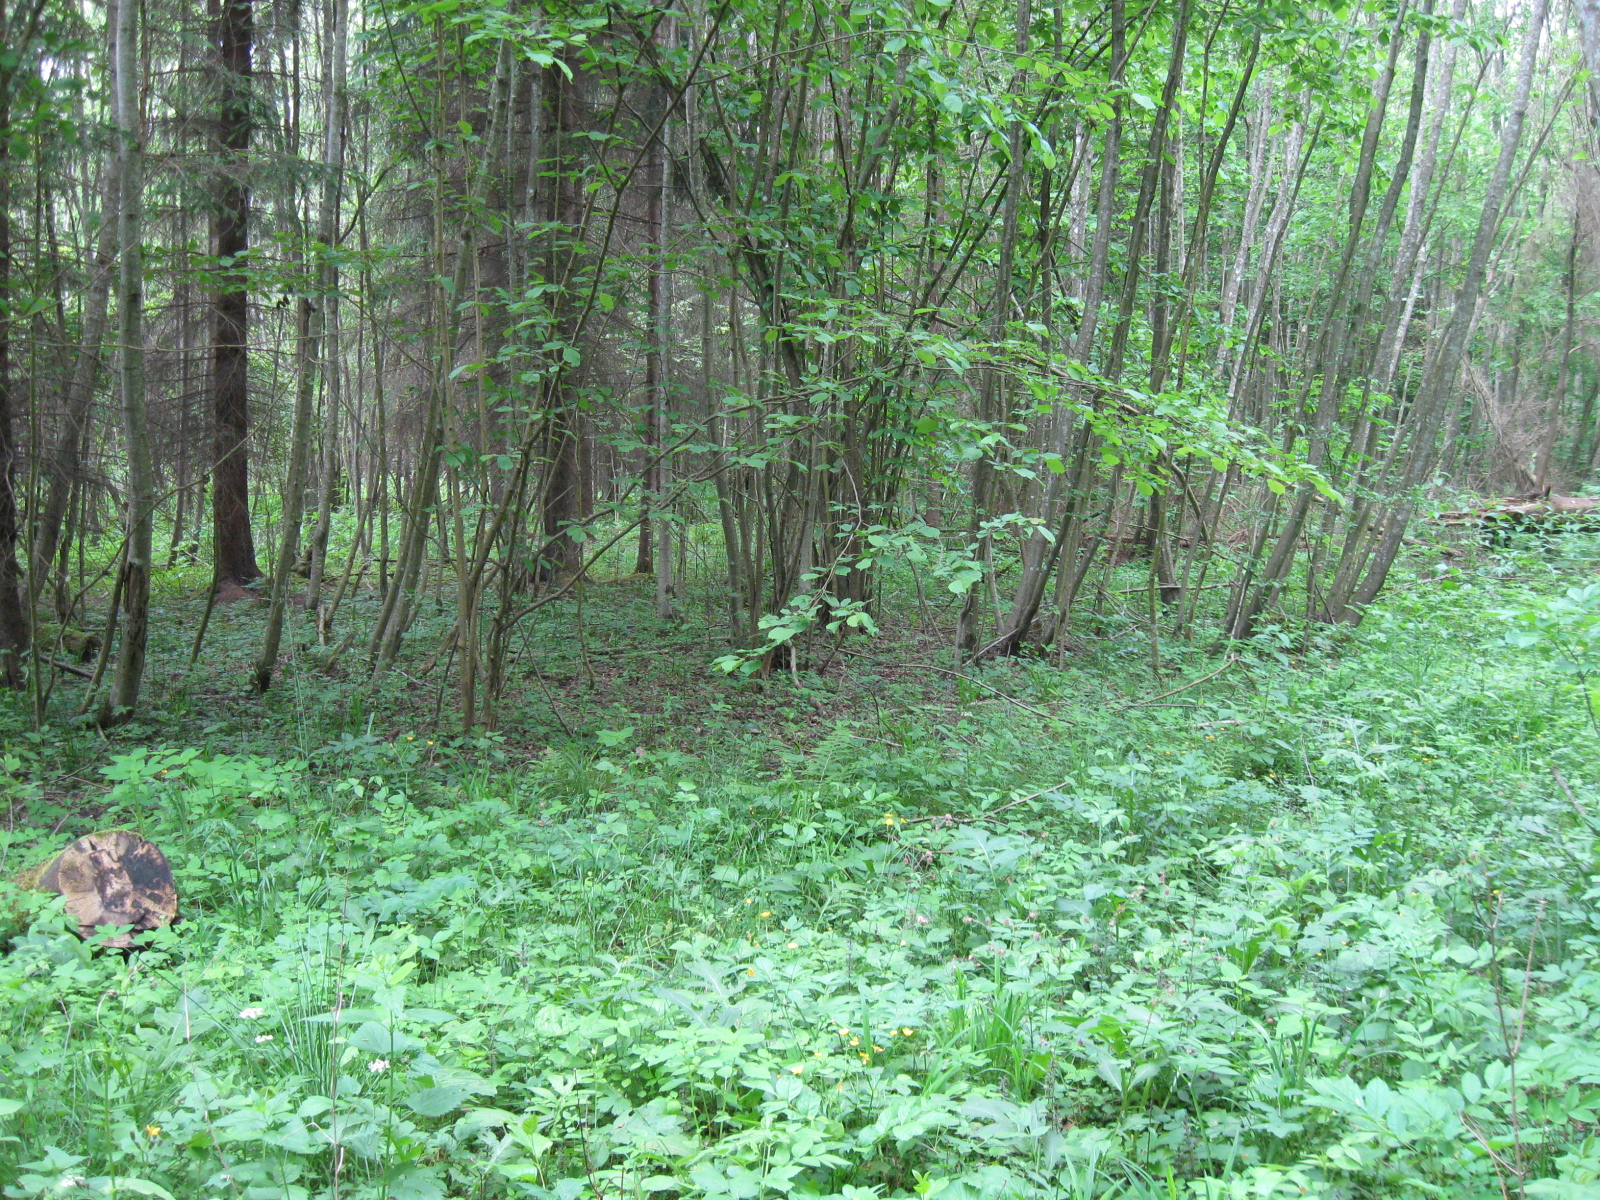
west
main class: Woodland
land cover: Spruce dominated mixed woodland
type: hemiboreal forest and nemoral coniferous forest and mixed broadleaved-coniferous forest
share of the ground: > 75 %
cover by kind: broadleaved forest trees 55 %, coniferous forest trees 35 %, herbaceous plants 10 %
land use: Forestry
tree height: > 5 m
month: June
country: LT
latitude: 55.0309
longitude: 23.8393
